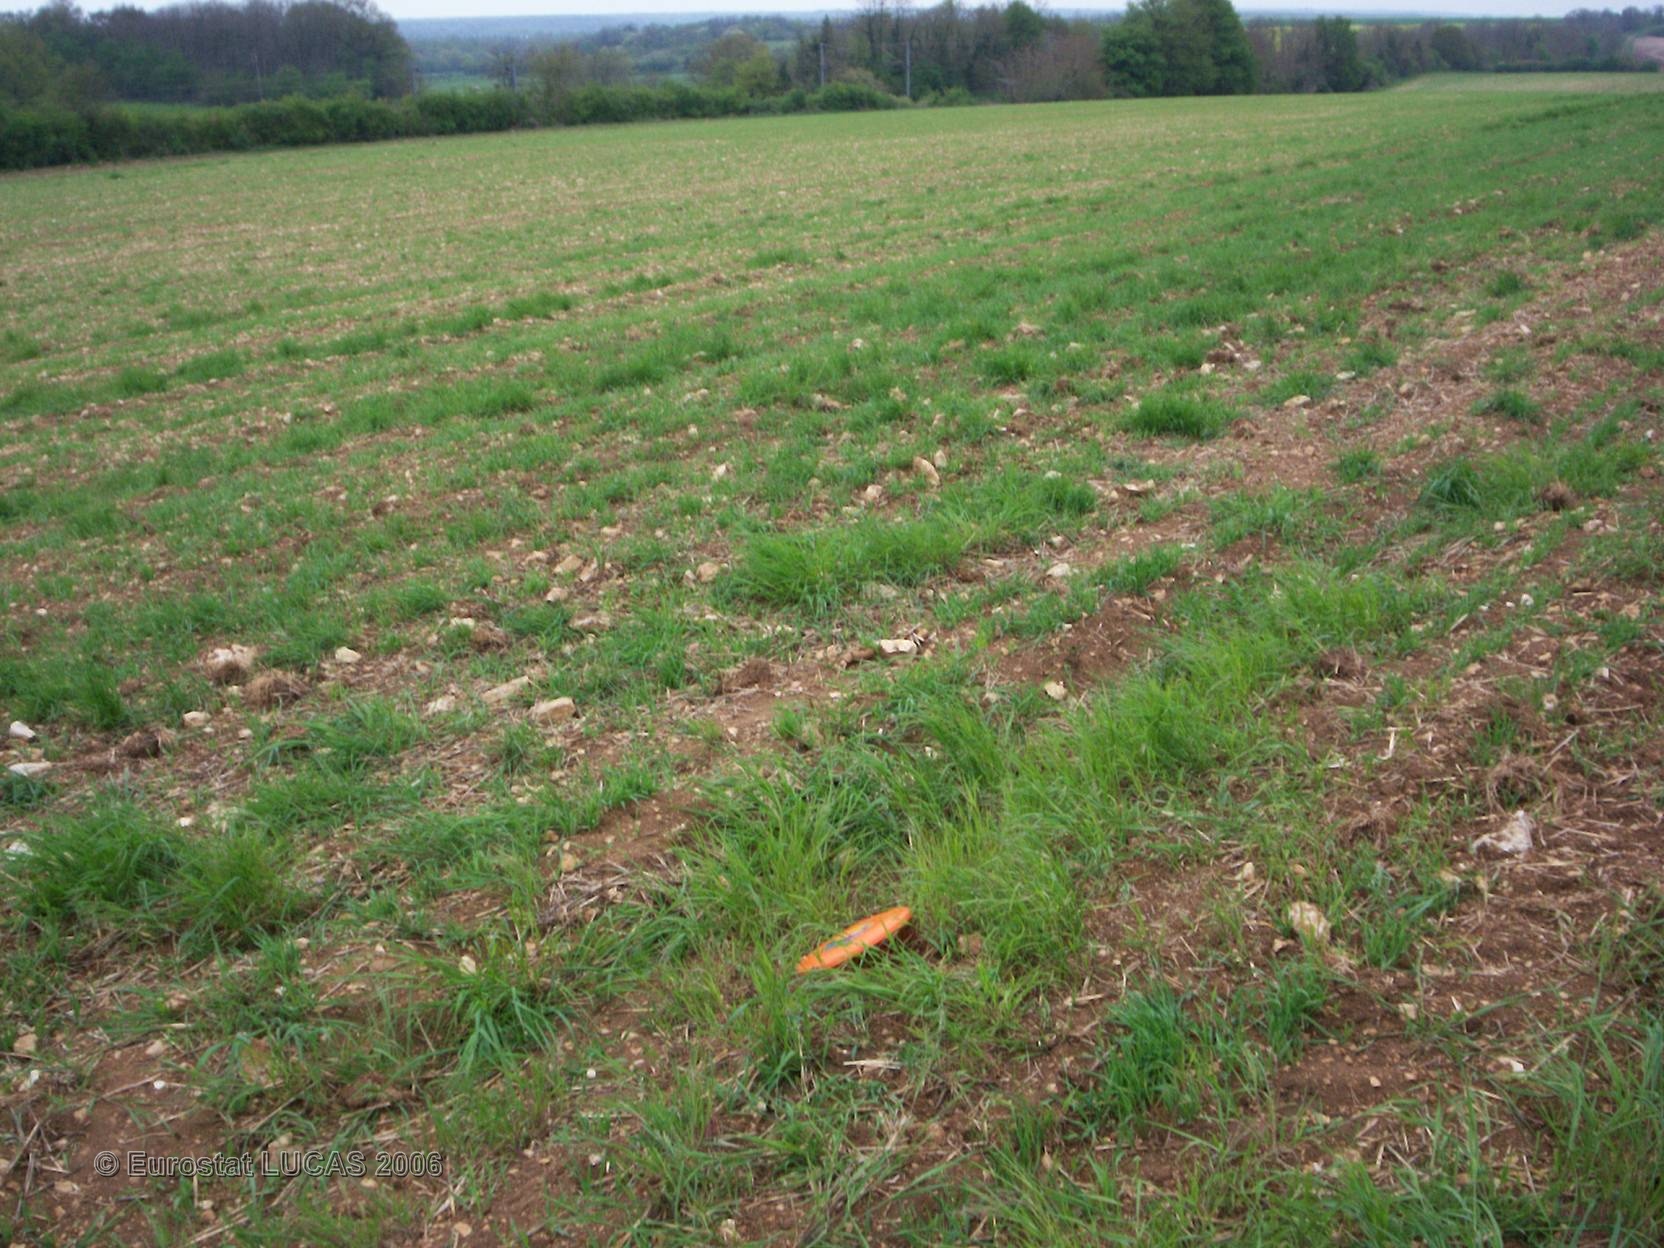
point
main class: Cropland
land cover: Barley
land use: Agriculture (excluding fallow land and kitchen gardens)
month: April
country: FR
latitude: 47.1189
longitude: 3.0495
